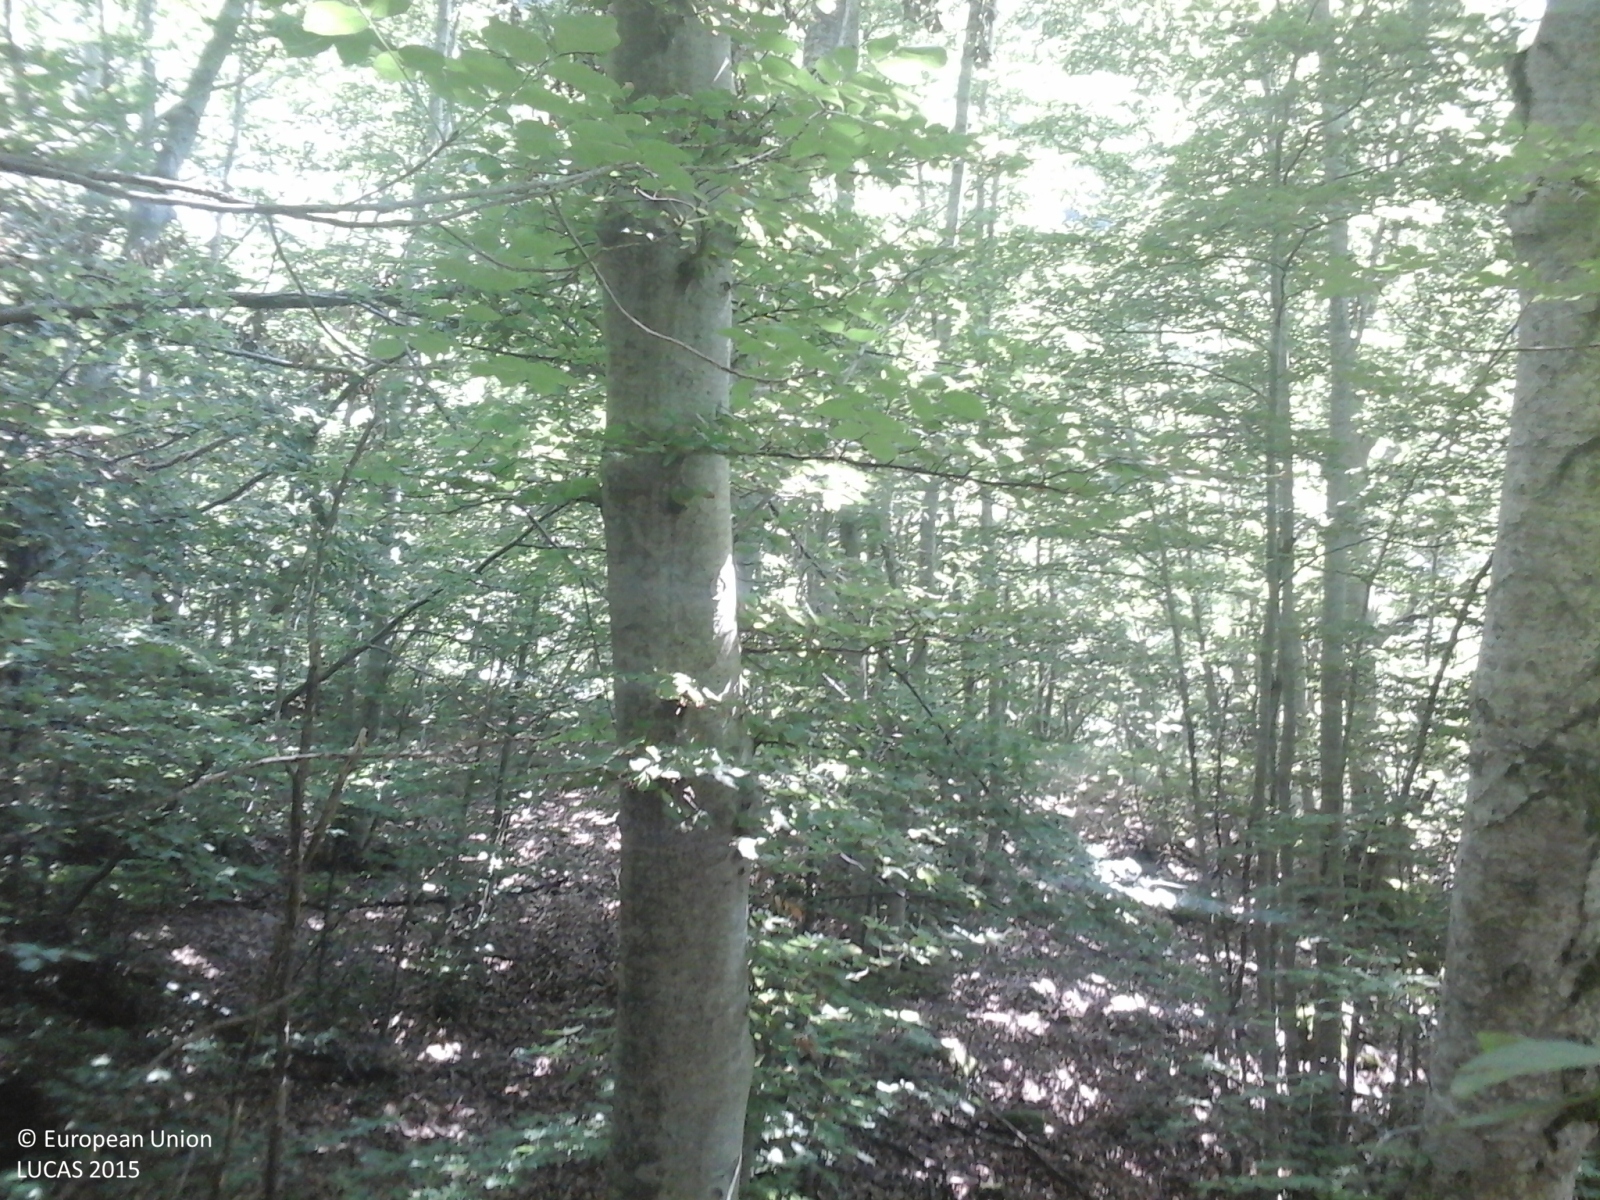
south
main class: Woodland
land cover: Broadleaved woodland
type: thermophilous deciduous forest
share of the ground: > 75 %
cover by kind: broadleaved forest trees 100 %
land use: Forestry
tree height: > 5 m
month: August
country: IT
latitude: 42.9472
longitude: 13.1898
